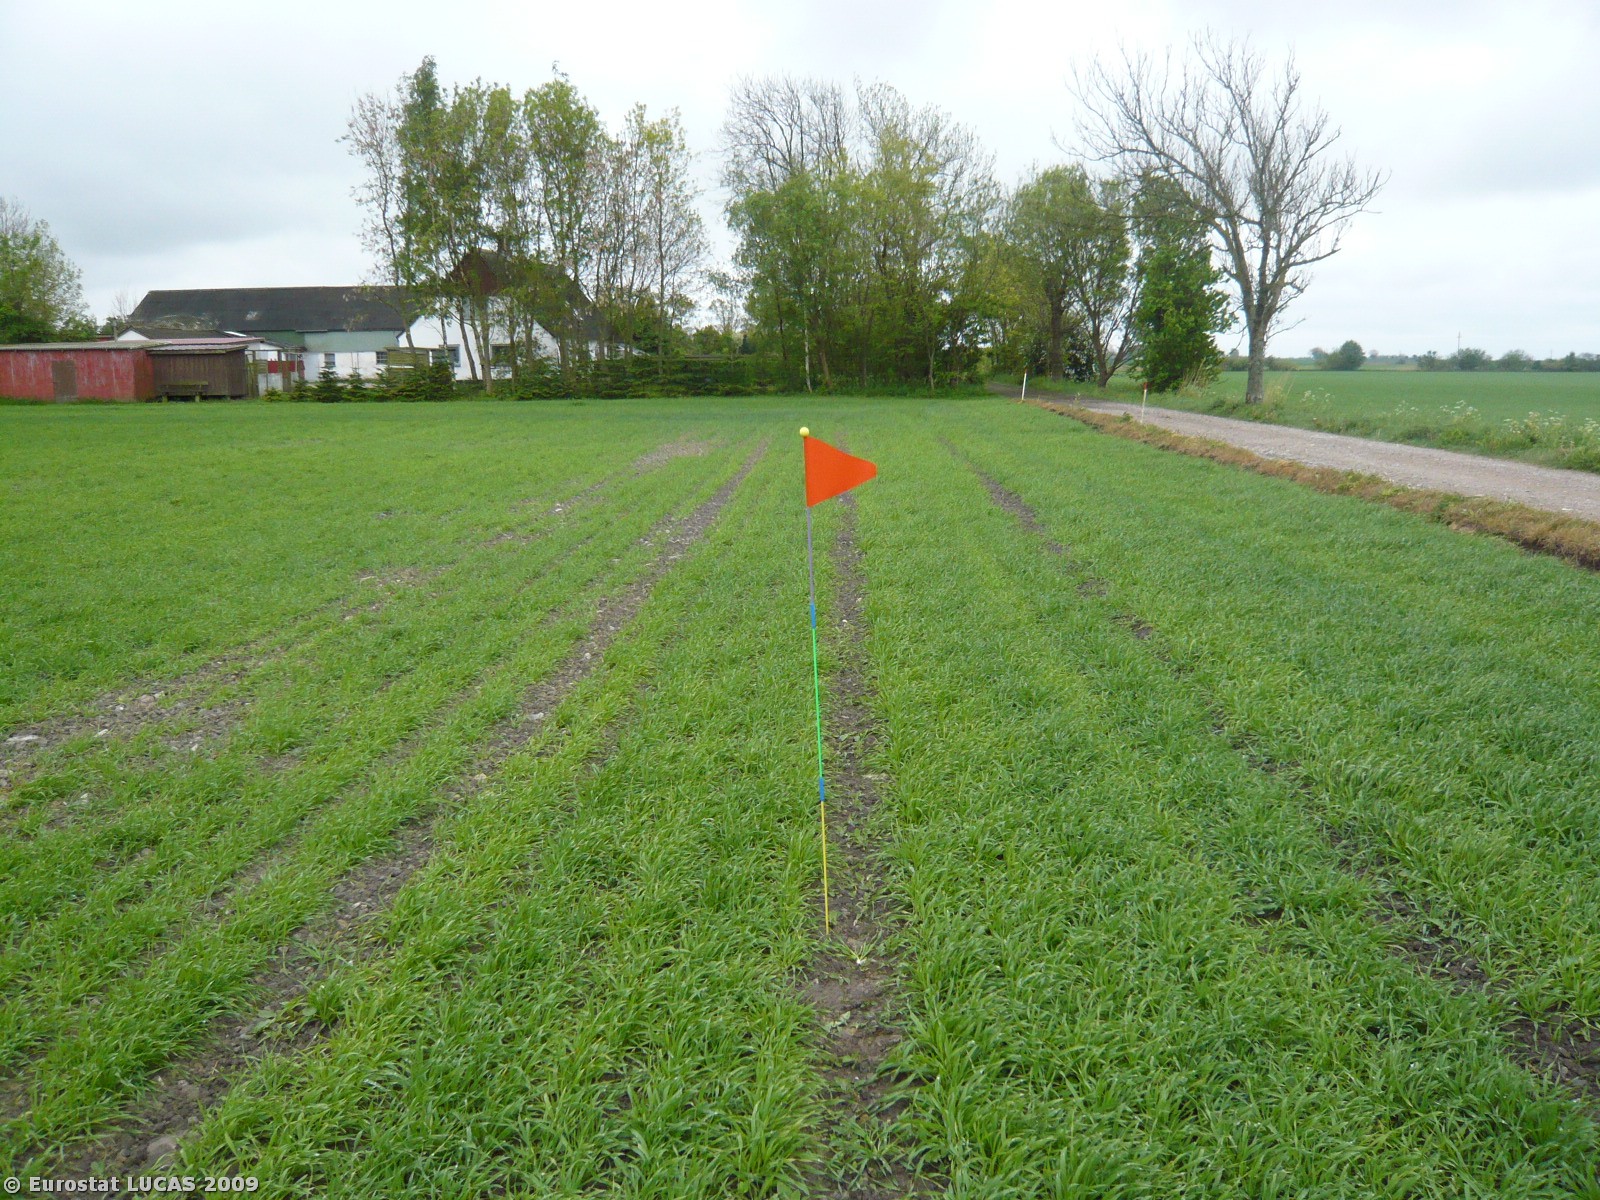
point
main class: Cropland
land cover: Barley
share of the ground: > 75 %
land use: Agriculture (excluding fallow land and kitchen gardens)
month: May
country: DK
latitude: 55.1148
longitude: 11.7703
